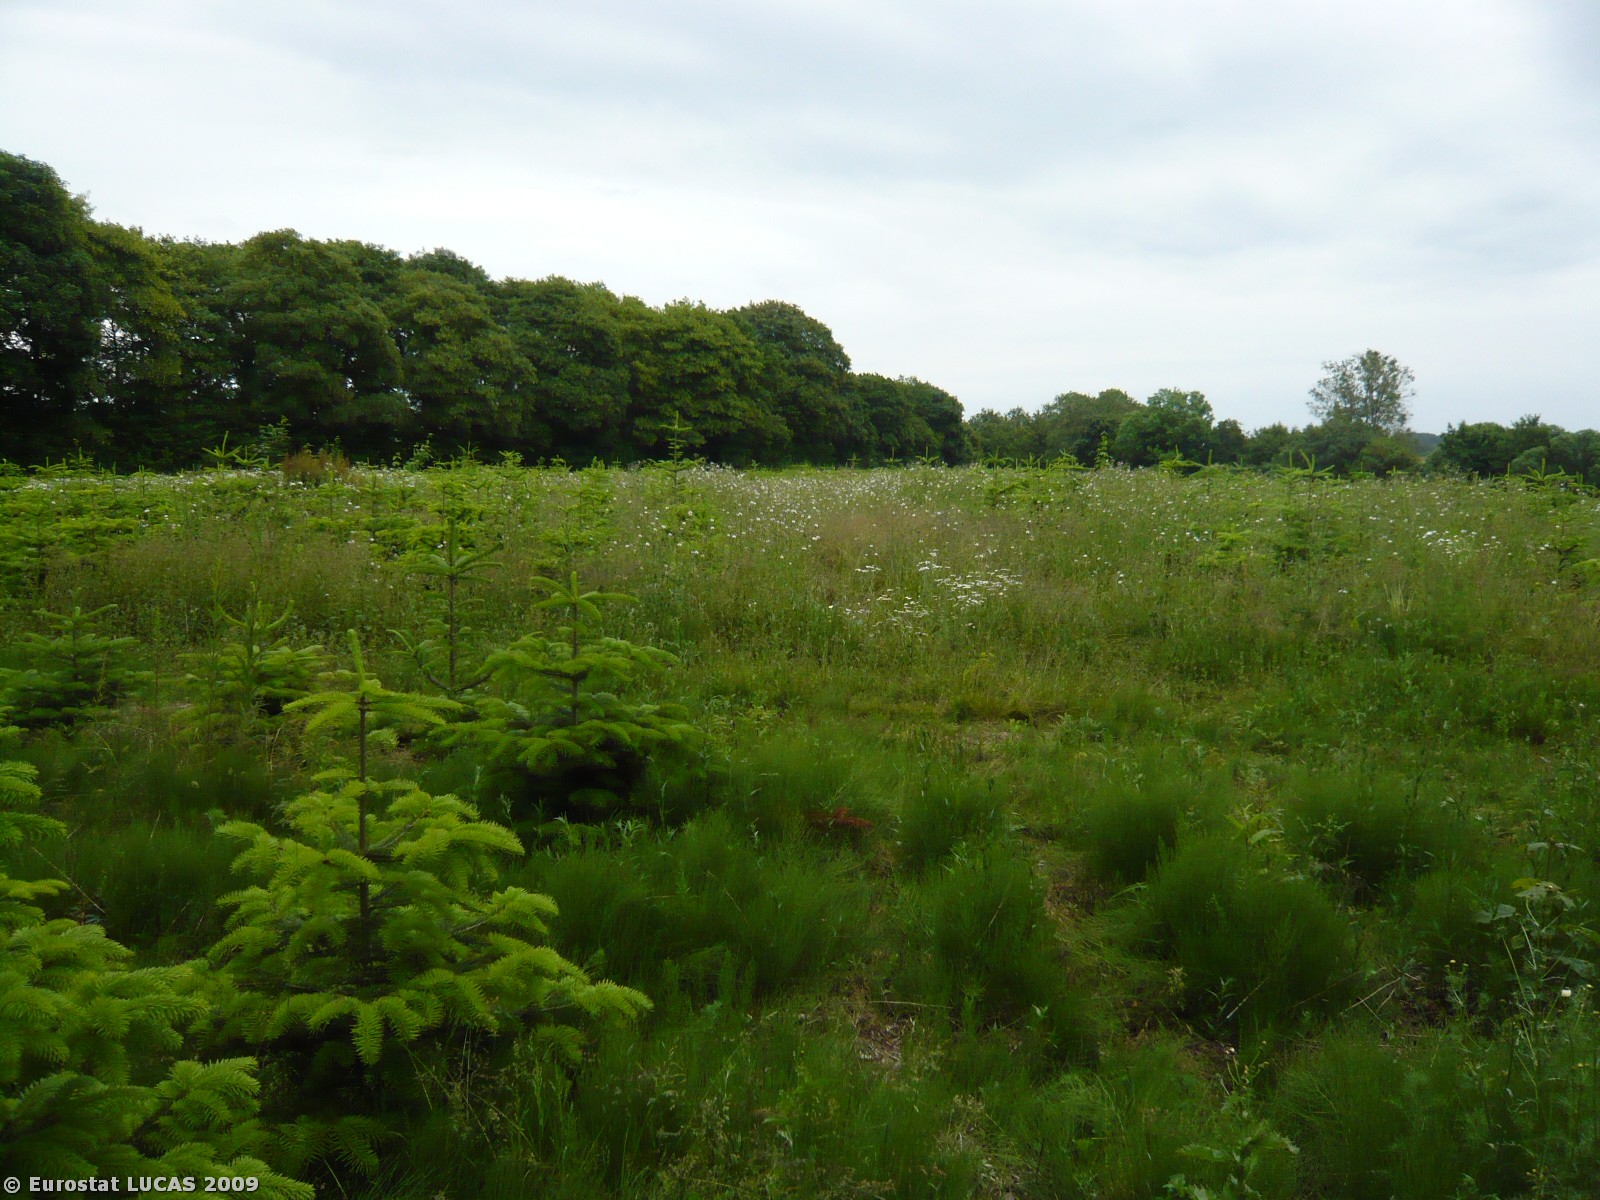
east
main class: Woodland
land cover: Broadleaved woodland
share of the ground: > 75 %
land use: Forestry
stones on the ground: < 10 %
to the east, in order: Broadleaved woodland; Fences; Coniferous woodland; Fences; Broadleaved woodland; Rivers and streams; Broadleaved woodland; Grassland without tree/shrub cover; Barley
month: June
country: DK
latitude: 55.1616
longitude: 10.6430
